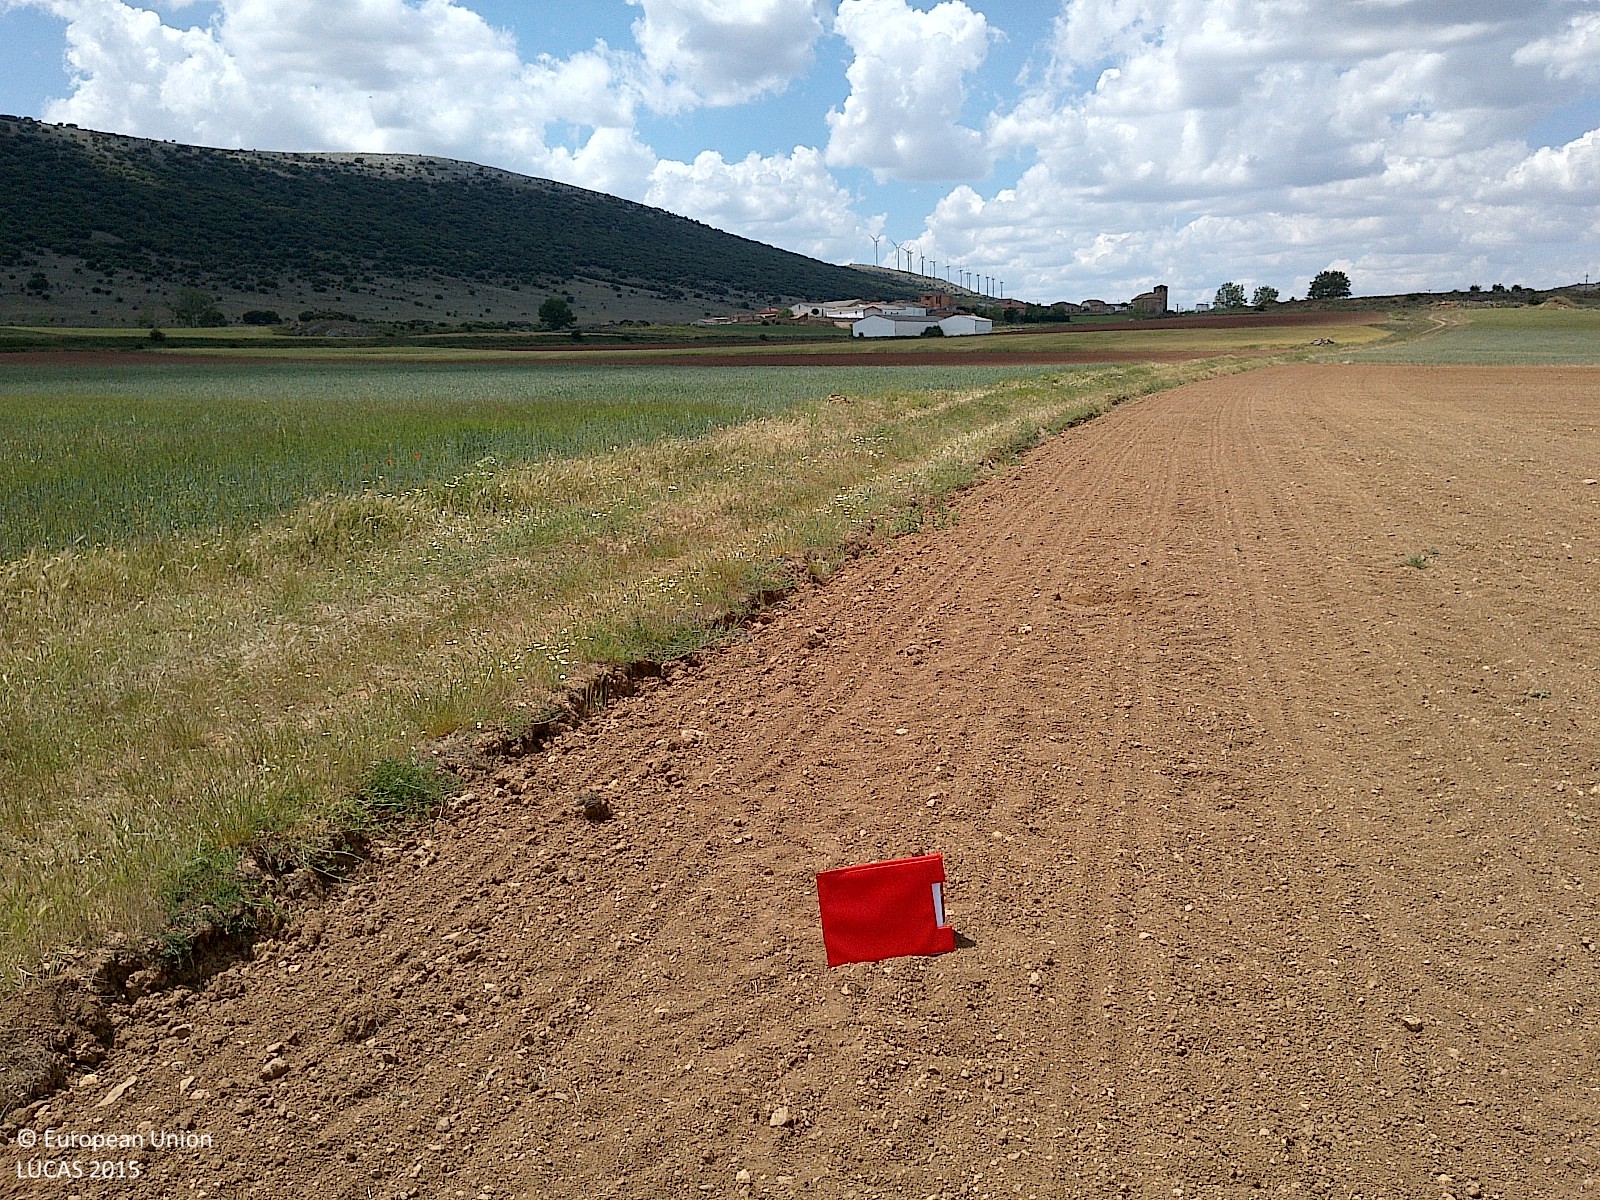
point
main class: Cropland
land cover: Sunflower
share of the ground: < 10 %
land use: Agriculture (excluding fallow land and kitchen gardens)
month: June
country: ES
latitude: 41.7382
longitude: -2.1419
